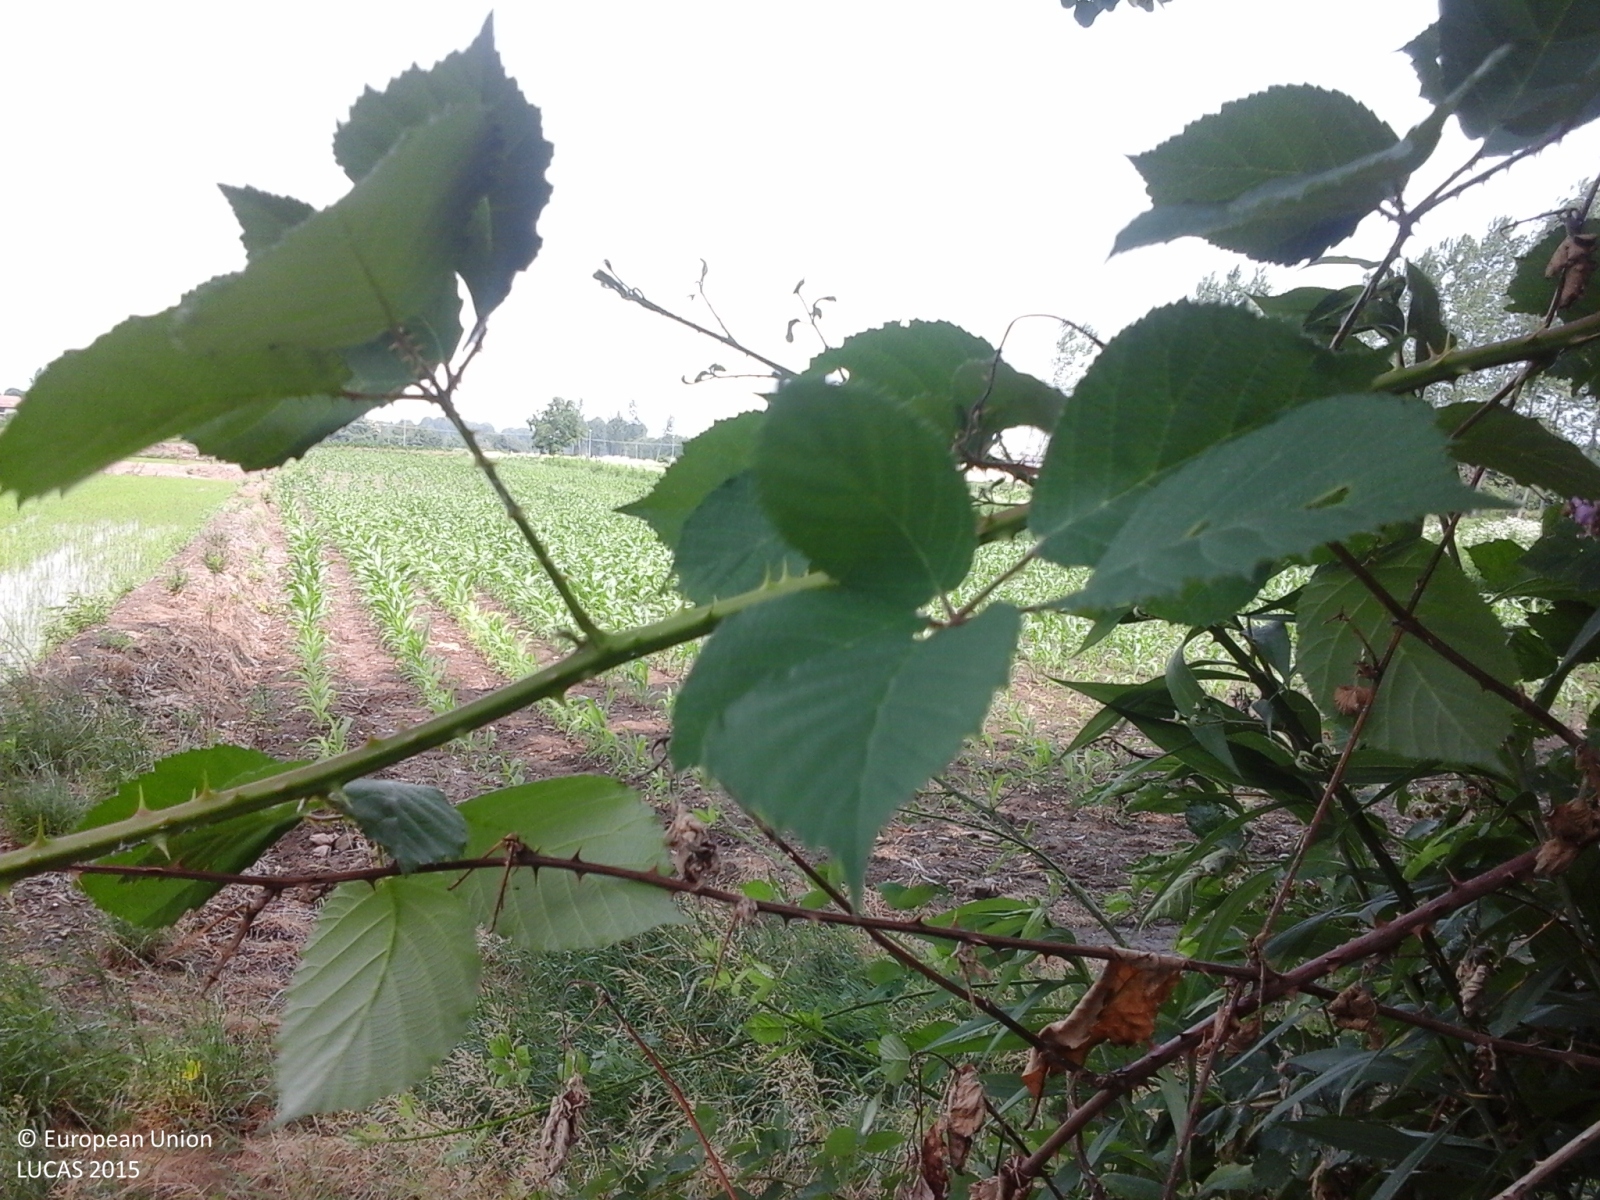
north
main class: Woodland
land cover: Broadleaved woodland
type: thermophilous deciduous forest
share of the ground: > 75 %
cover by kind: broadleaved forest trees 100 %
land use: Forestry
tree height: > 5 m
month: June
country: IT
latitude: 45.4927
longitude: 8.4287
